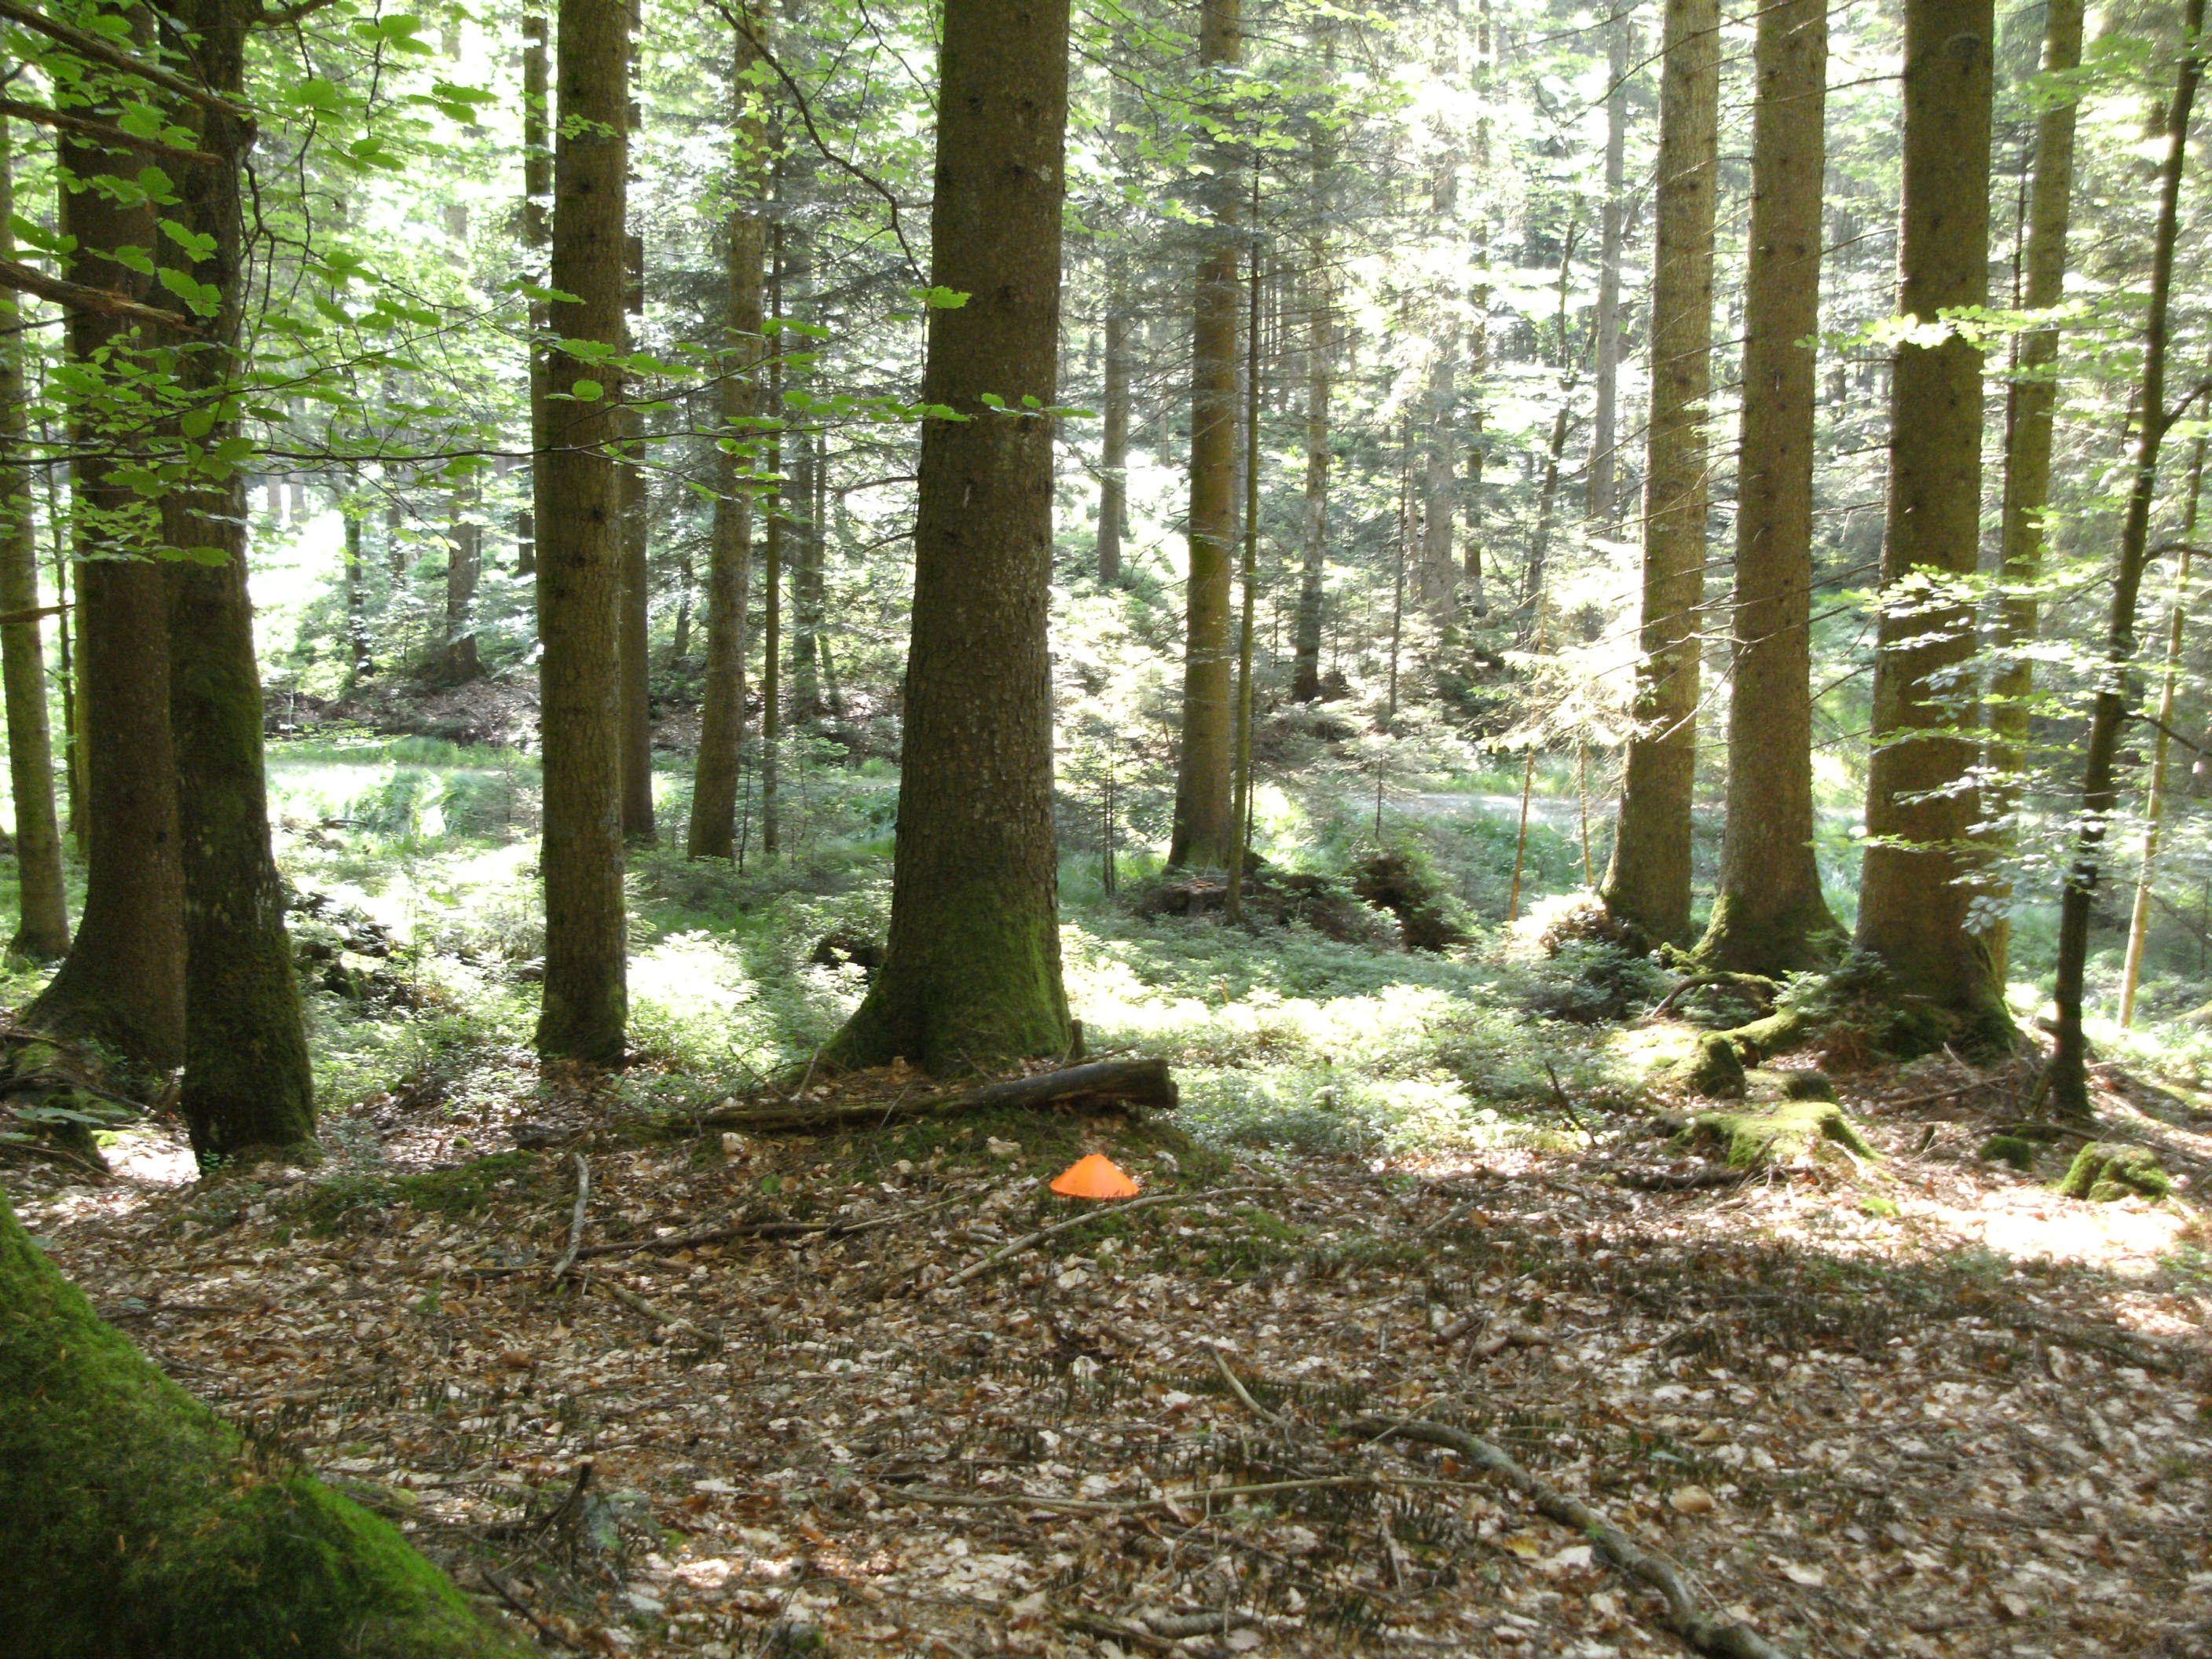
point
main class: Woodland
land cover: Other mixed woodland
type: hemiboreal forest and nemoral coniferous forest and mixed broadleaved-coniferous forest
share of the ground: > 75 %
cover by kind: broadleaved forest trees 55 %, coniferous forest trees 35 %, herbaceous plants 5 %, lichens and mosses 5 %
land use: Forestry
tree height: > 5 m
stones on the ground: < 10 %
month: June
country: AT
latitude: 48.0829
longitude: 13.3416
